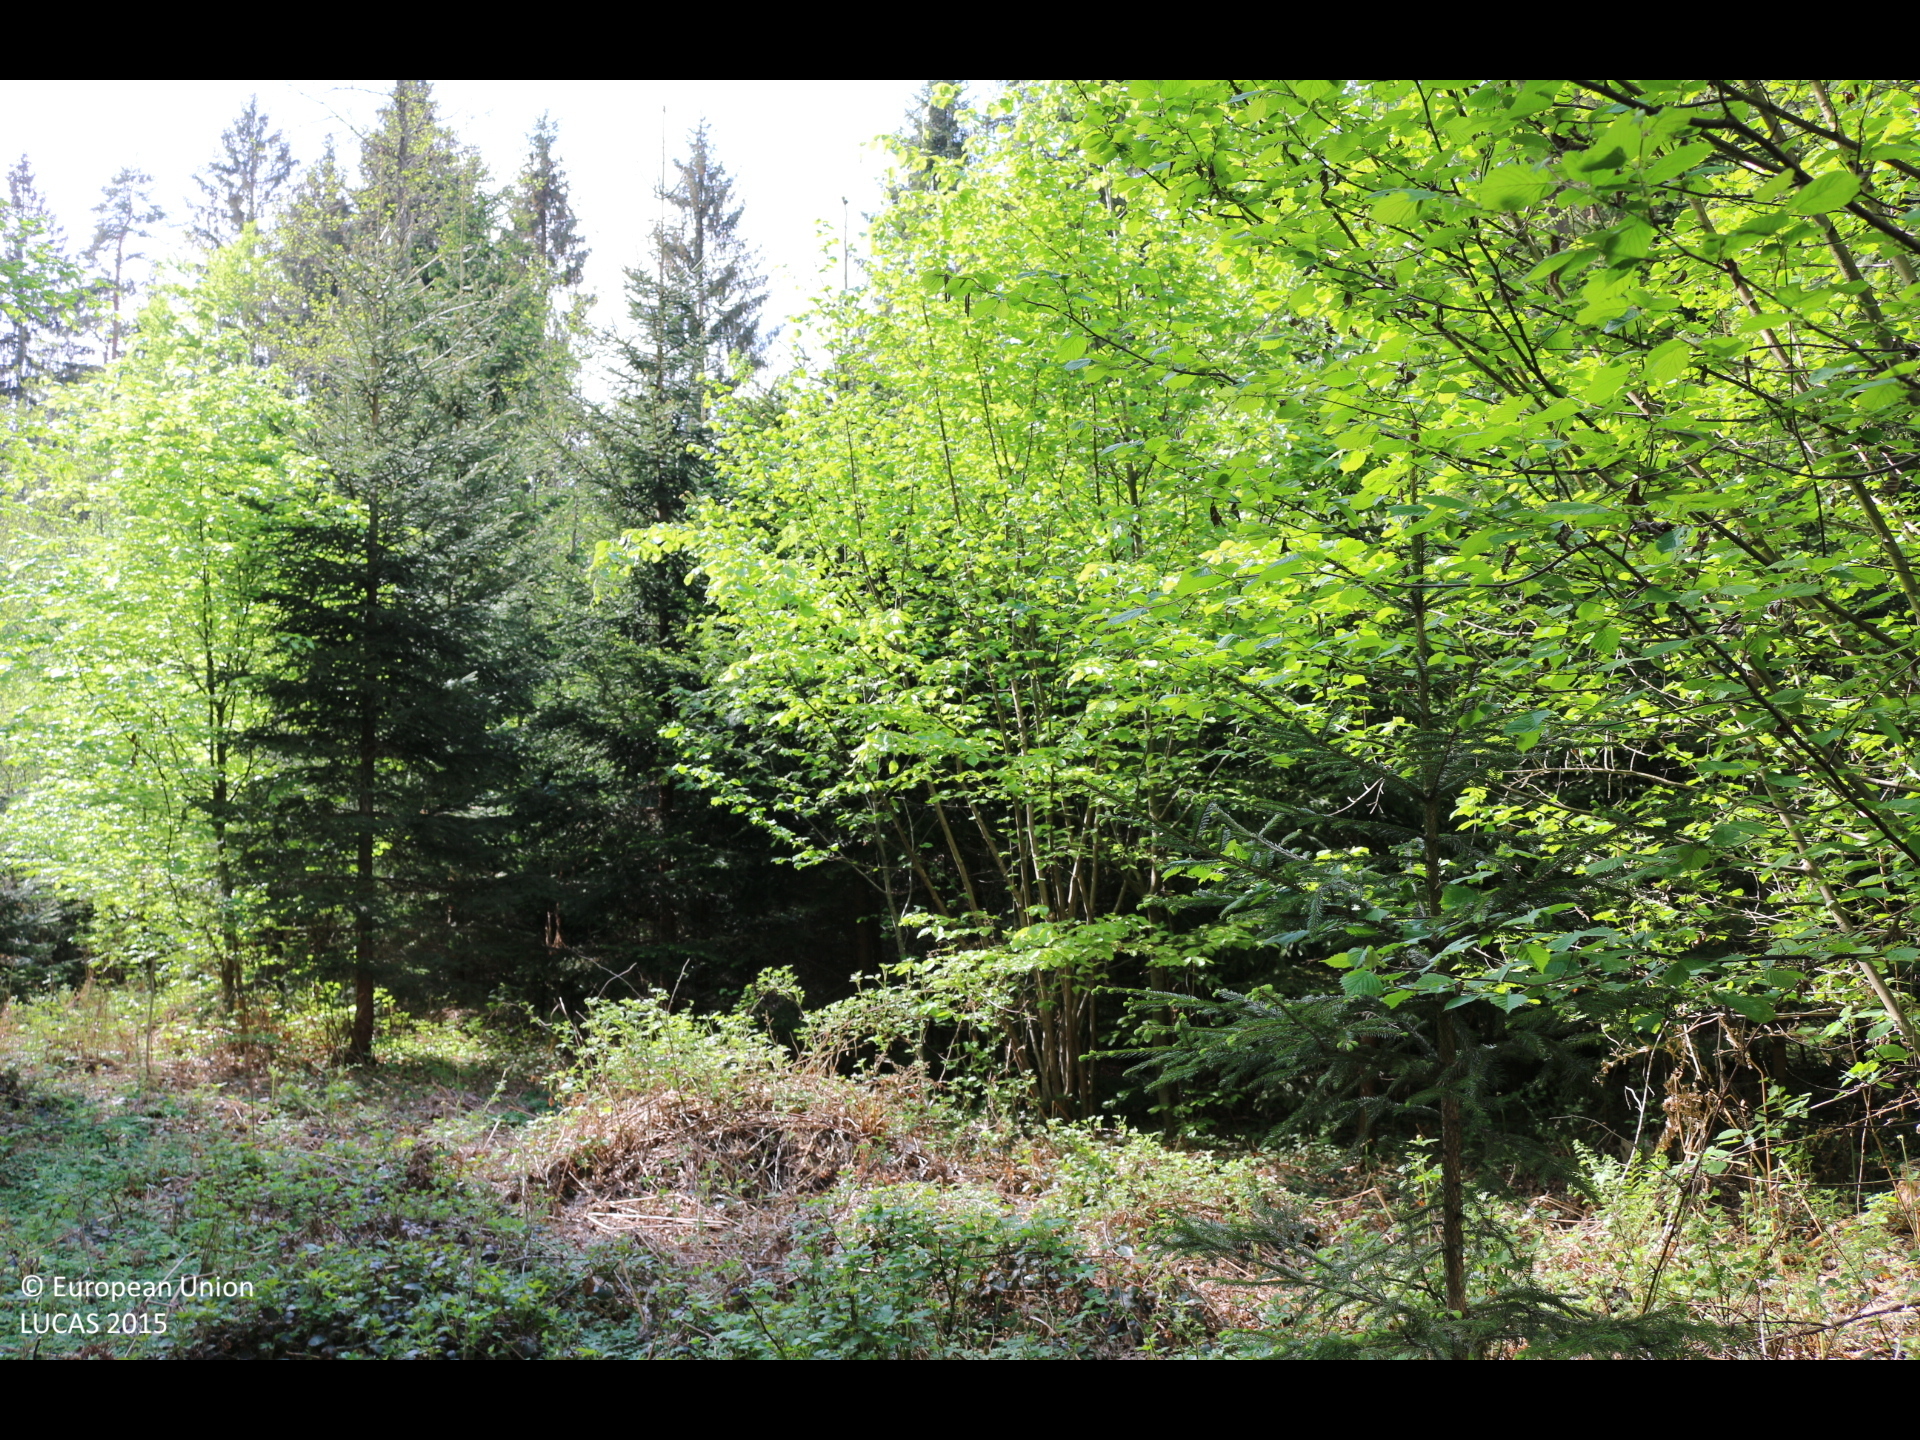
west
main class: Woodland
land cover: Spruce dominated mixed woodland
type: mountainous beech forest
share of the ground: > 75 %
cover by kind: broadleaved forest trees 50 %, coniferous forest trees 40 %, shrubs 10 %
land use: Forestry
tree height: > 5 m
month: May
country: AT
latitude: 46.6468
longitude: 14.2176
